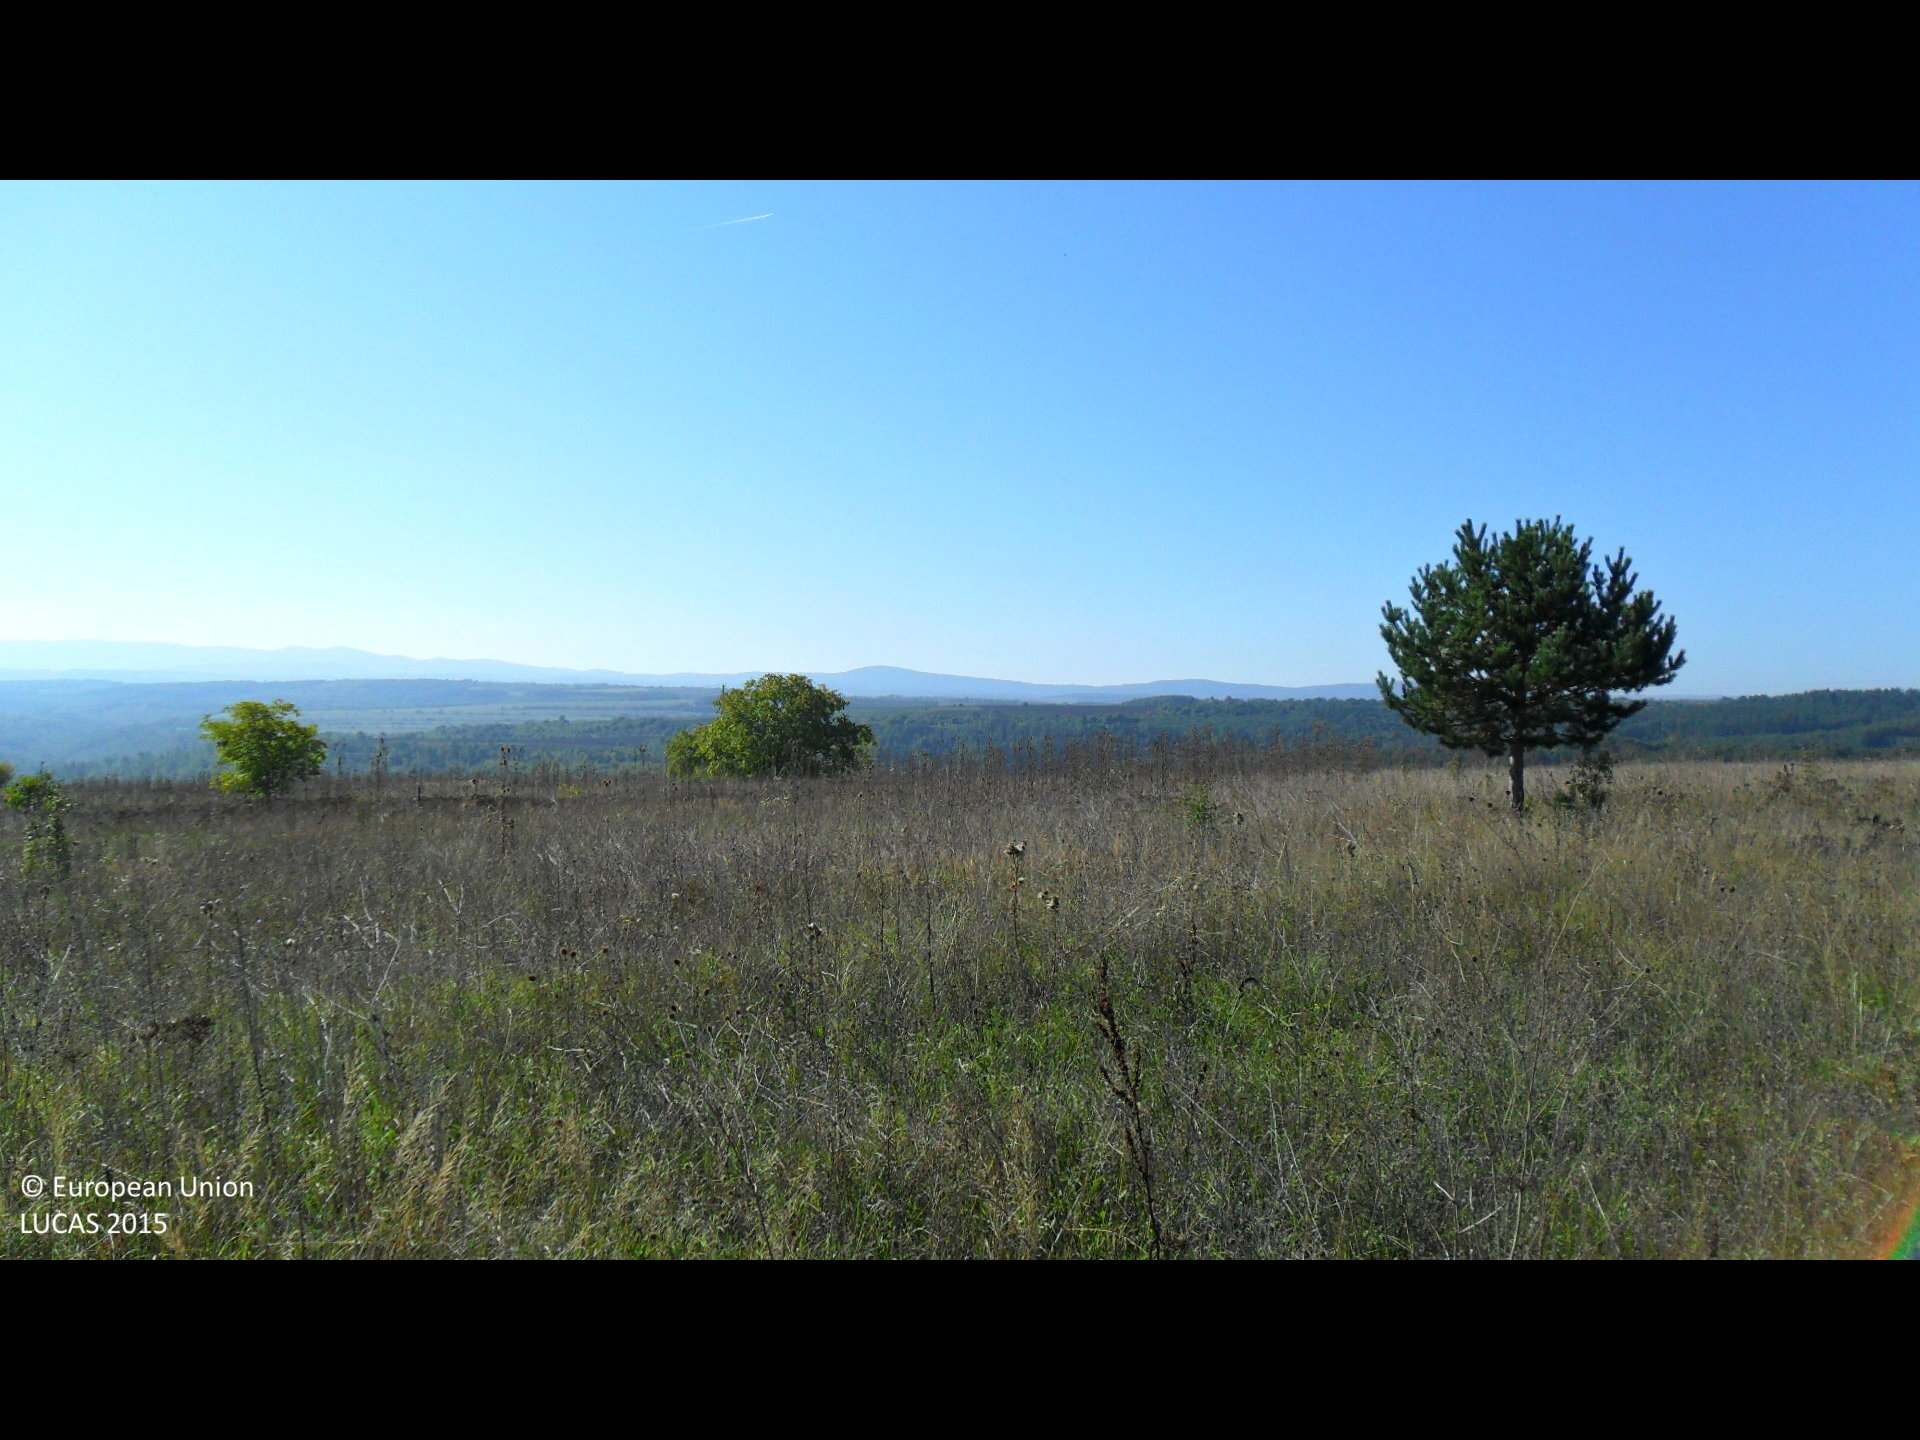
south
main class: Grassland
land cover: Grassland without tree/shrub cover
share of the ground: > 75 %
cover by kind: herbaceous plants 100 %
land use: Semi-natural and natural areas not in use
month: October
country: BG
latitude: 43.1703
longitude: 26.2455
